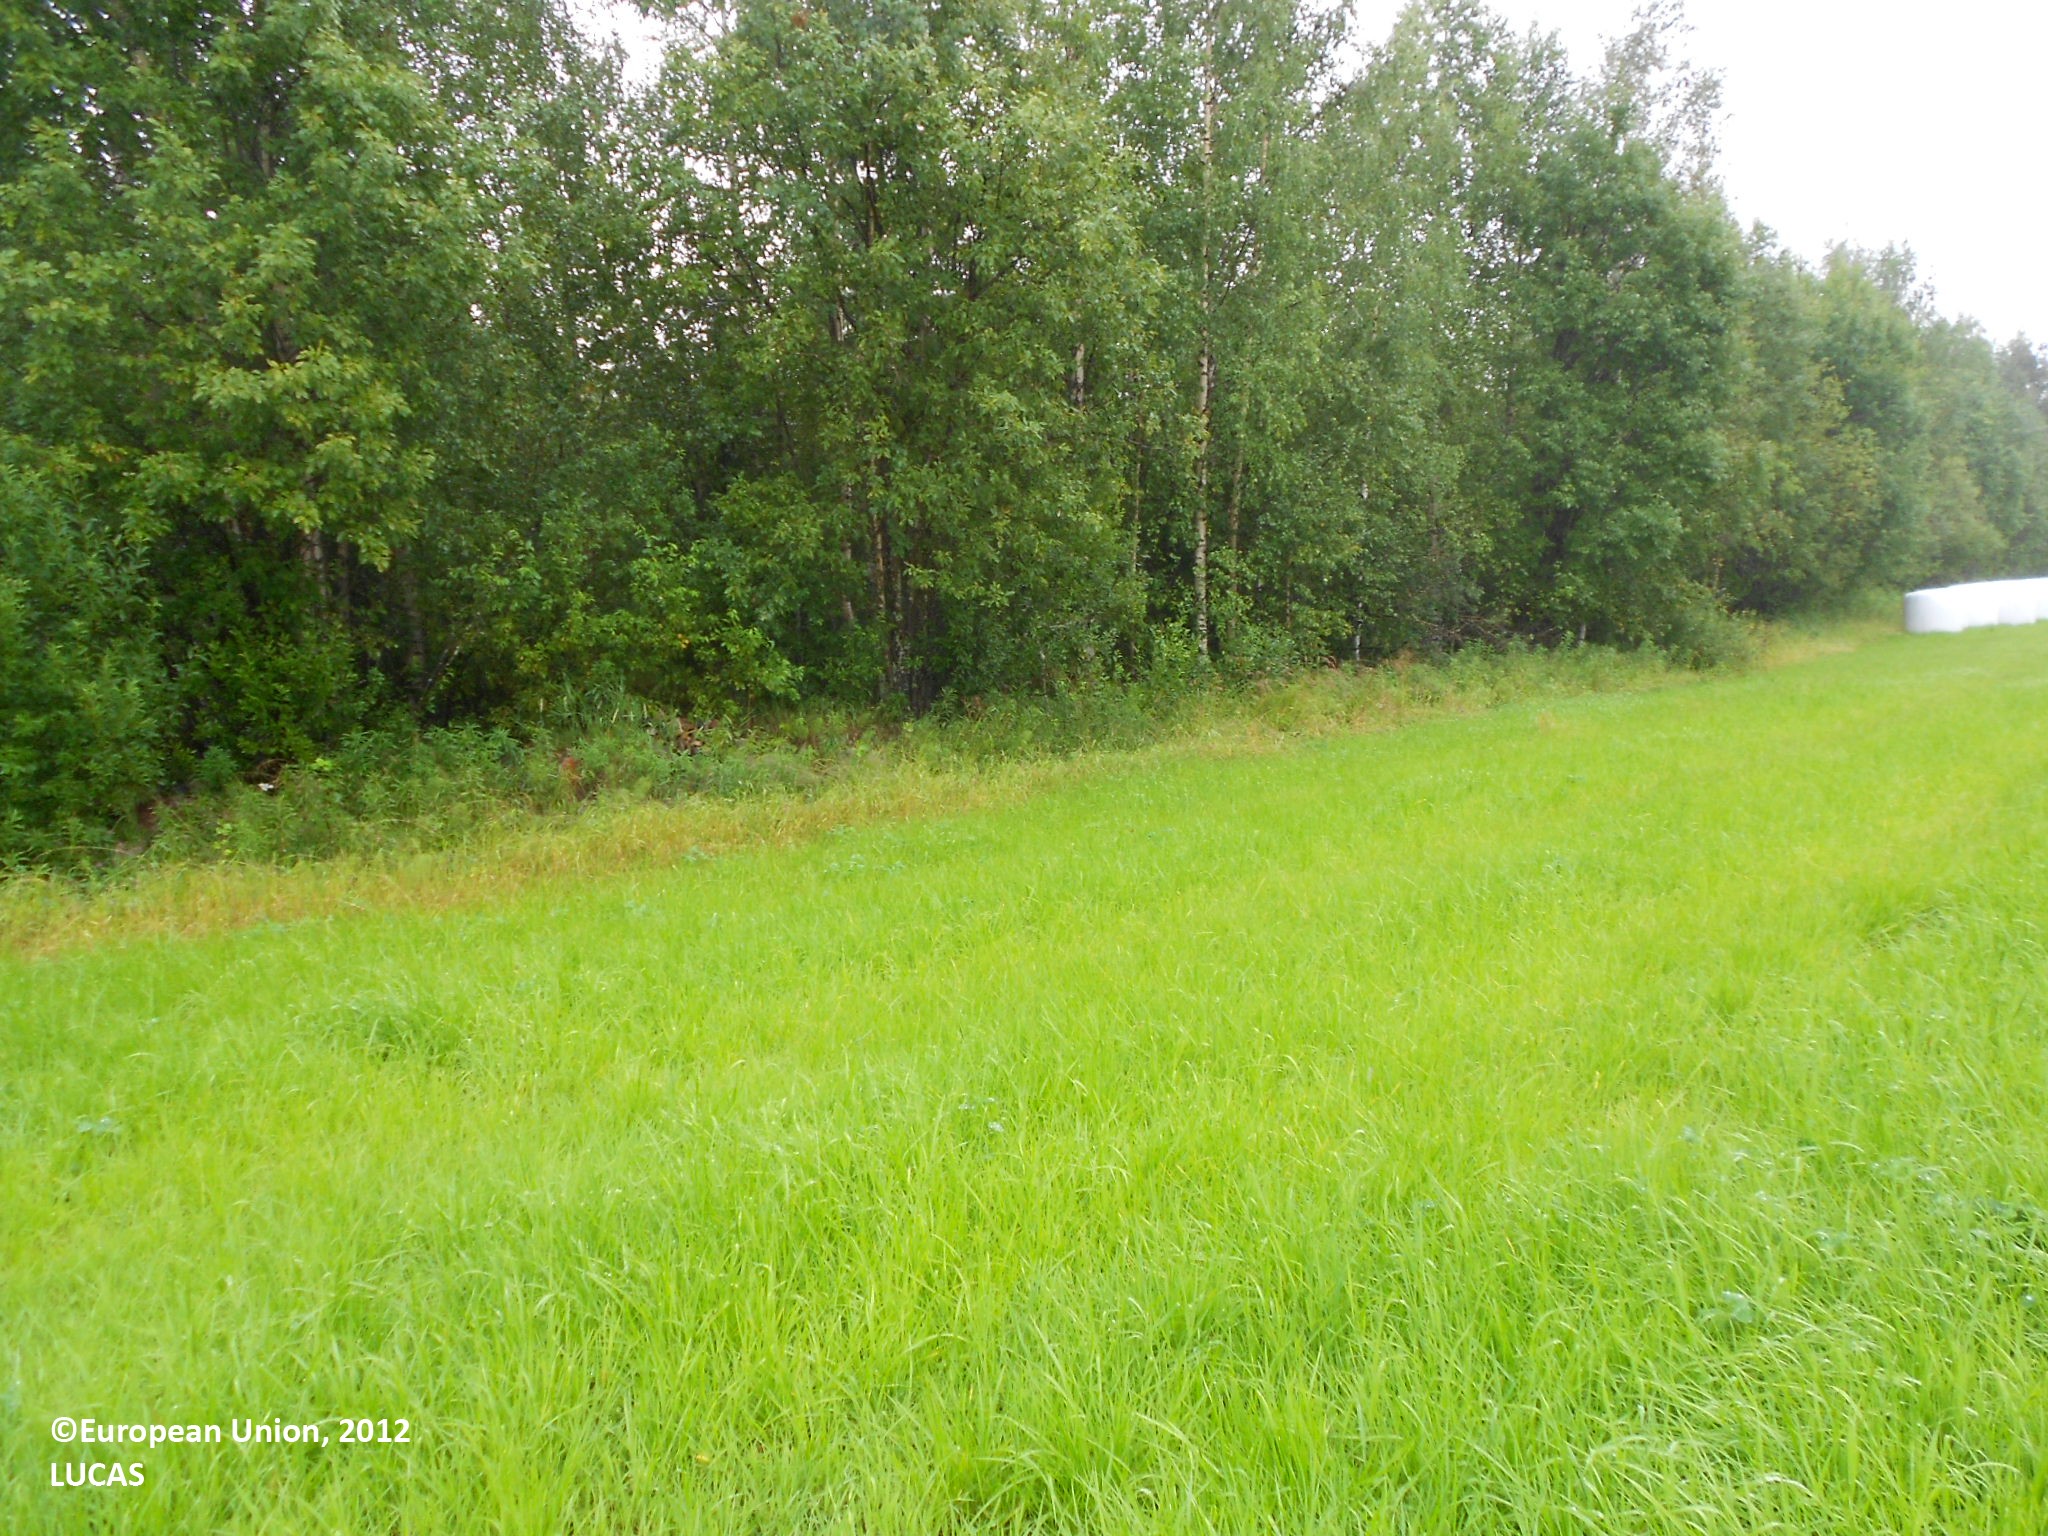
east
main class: Cropland
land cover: Temporary grasslands
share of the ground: > 75 %
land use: Agriculture (excluding fallow land and kitchen gardens)
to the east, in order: Temporary grasslands; Pine dominated mixed woodland; Ditches and canals; Pine dominated coniferous woodland; Inland water bodies
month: August
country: FI
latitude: 63.9943
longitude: 28.2656
